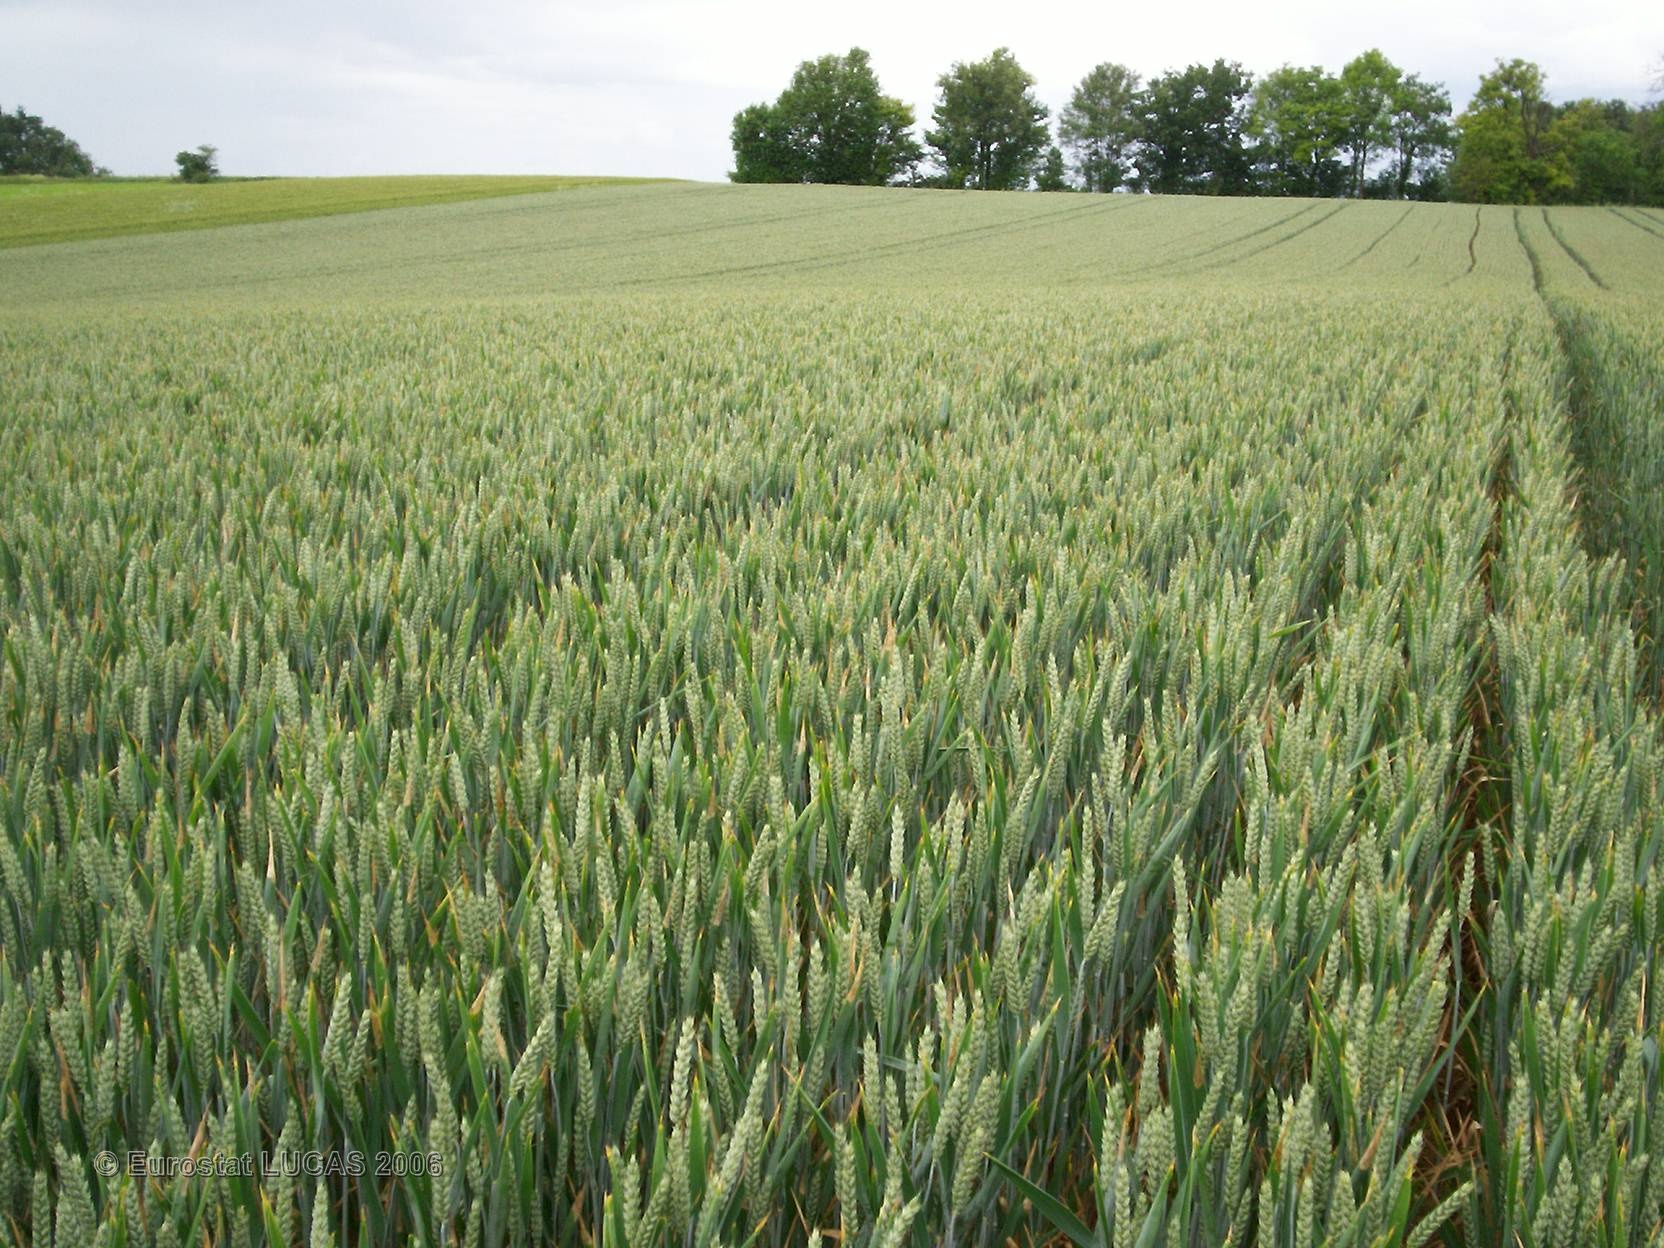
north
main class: Cropland
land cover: Common wheat
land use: Agriculture (excluding fallow land and kitchen gardens)
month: May
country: FR
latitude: 43.6113
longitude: 0.9676
